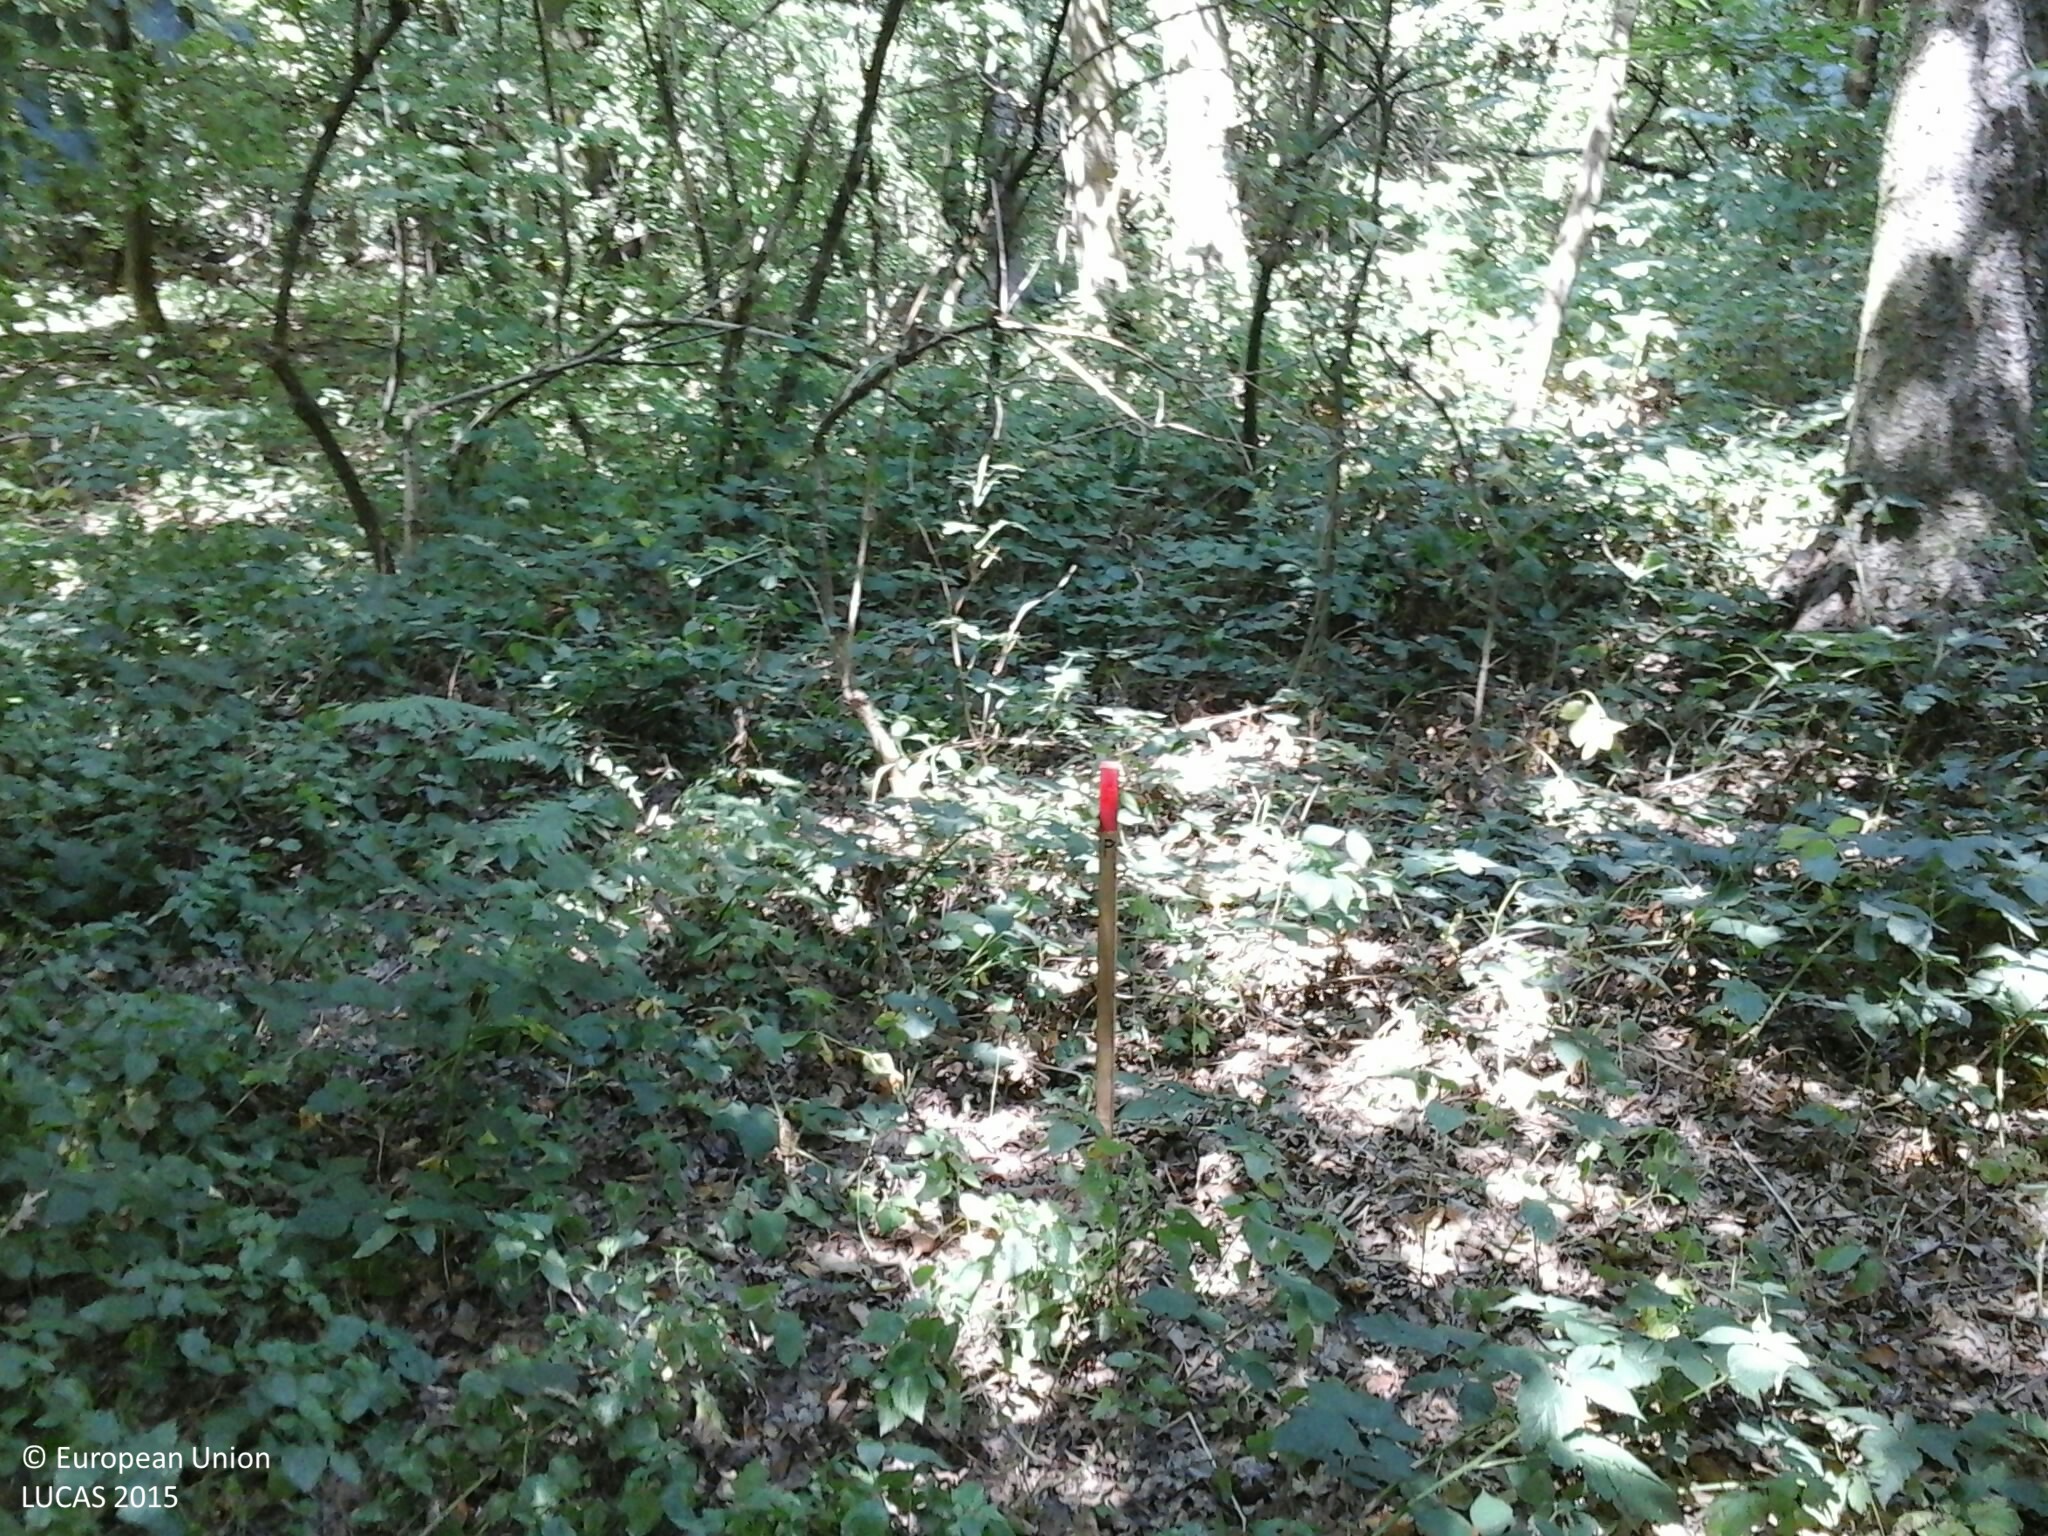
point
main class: Woodland
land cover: Broadleaved woodland
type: mesophytic deciduous forest
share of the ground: > 75 %
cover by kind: broadleaved forest trees 80 %, shrubs 20 %
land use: Forestry
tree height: > 5 m
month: July
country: HU
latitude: 46.9937
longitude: 16.6435
